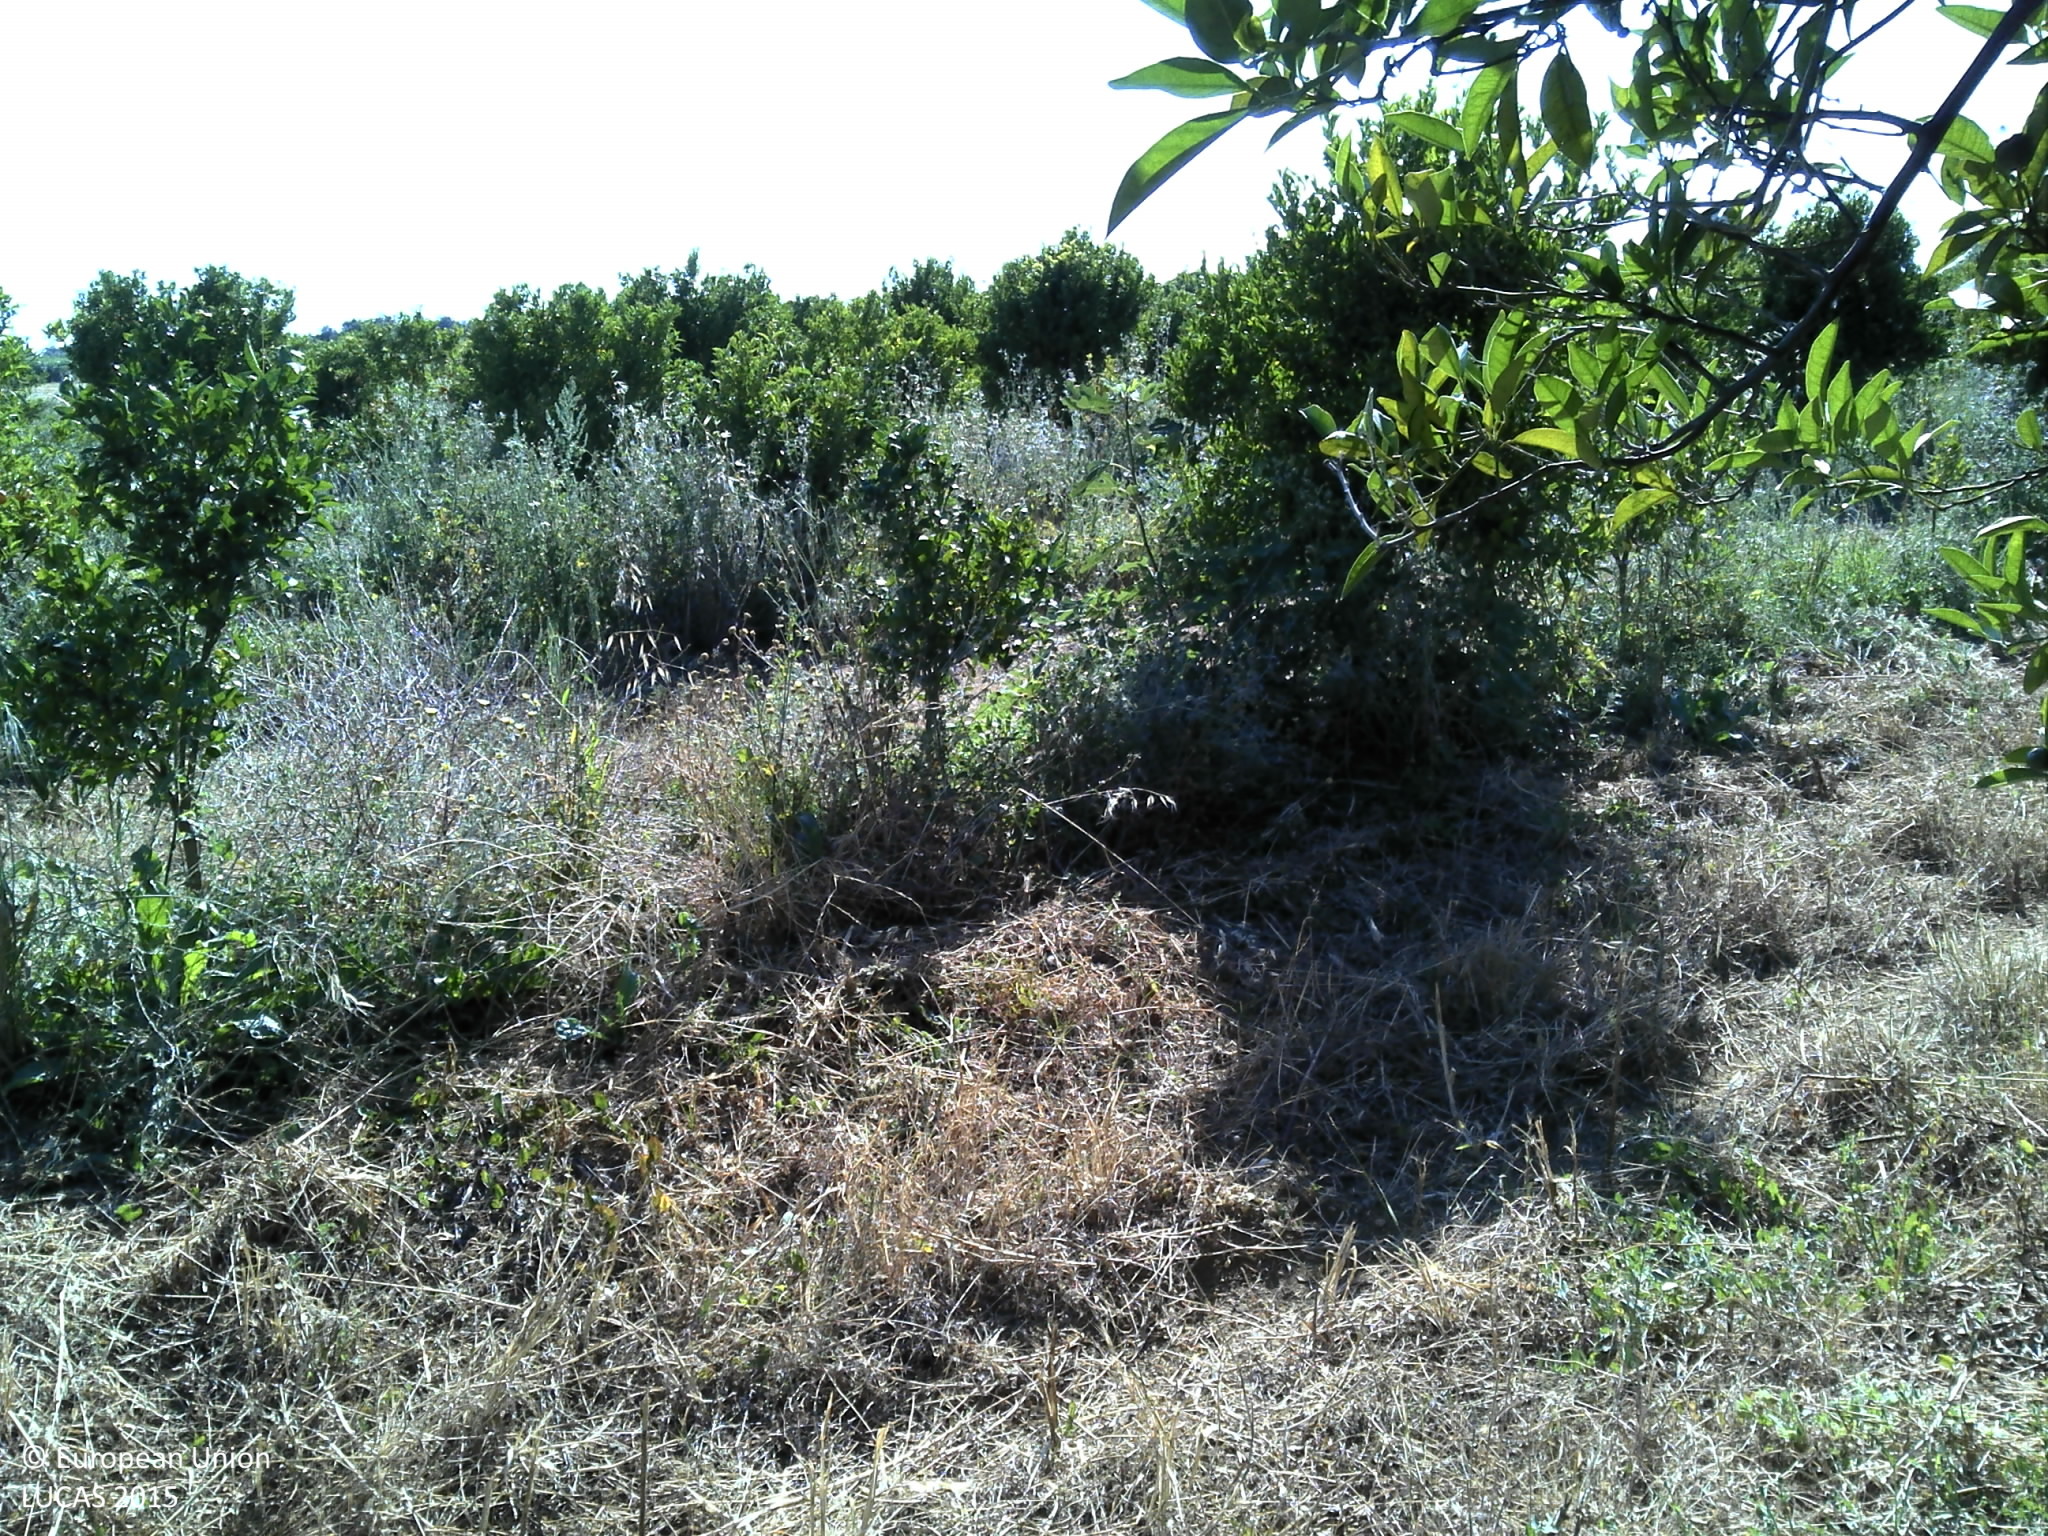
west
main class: Cropland
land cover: Oranges
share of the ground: > 75 %
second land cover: Spontaneously vegetated surfaces
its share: 10 - 25 %
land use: Agriculture (excluding fallow land and kitchen gardens)
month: June
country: PT
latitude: 37.1162
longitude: -7.6626
